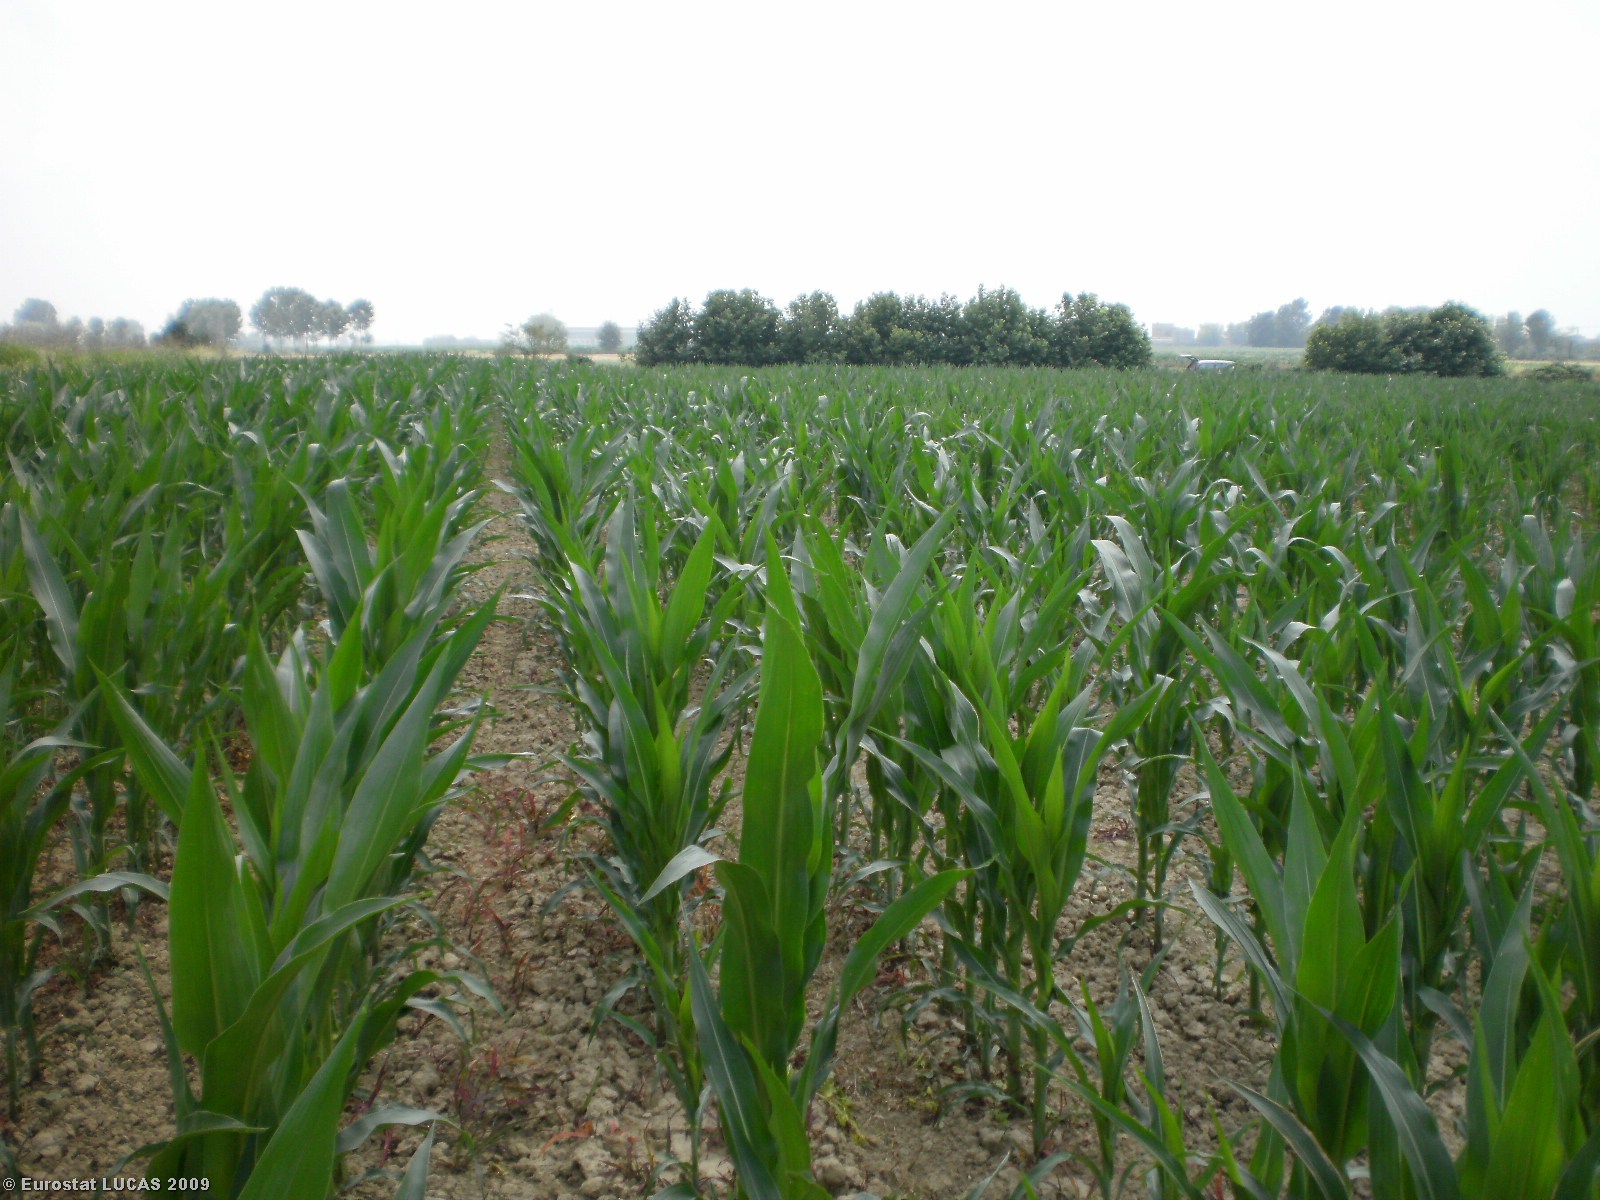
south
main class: Cropland
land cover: Maize
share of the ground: > 75 %
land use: Agriculture (excluding fallow land and kitchen gardens)
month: June
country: IT
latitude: 45.1075
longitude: 10.2664
